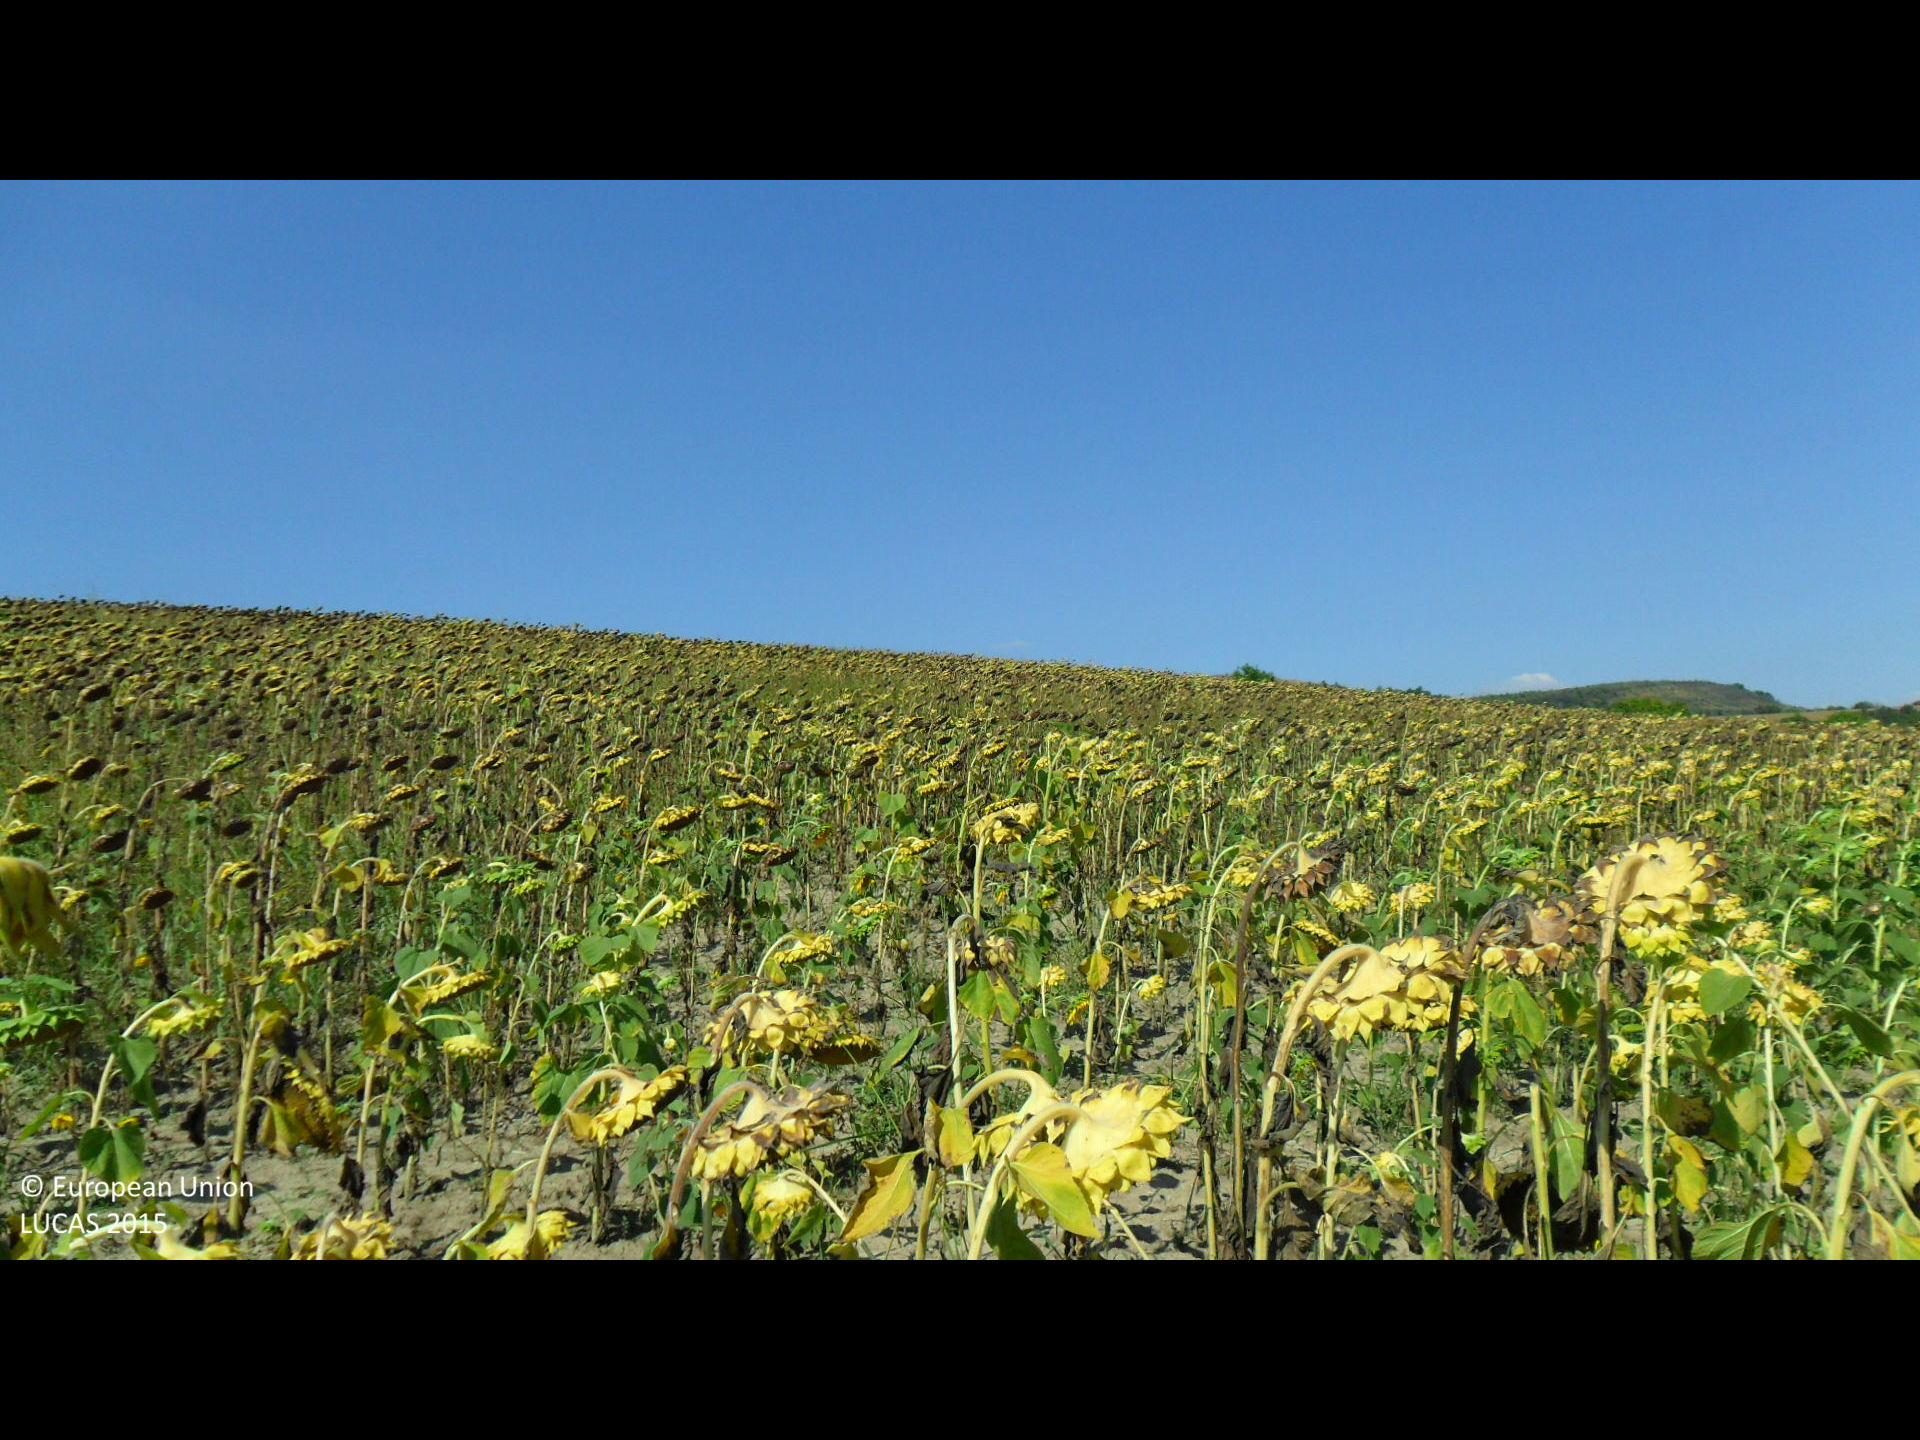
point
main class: Cropland
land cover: Sunflower
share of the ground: > 75 %
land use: Agriculture (excluding fallow land and kitchen gardens)
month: August
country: BG
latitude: 43.4650
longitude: 26.3545
